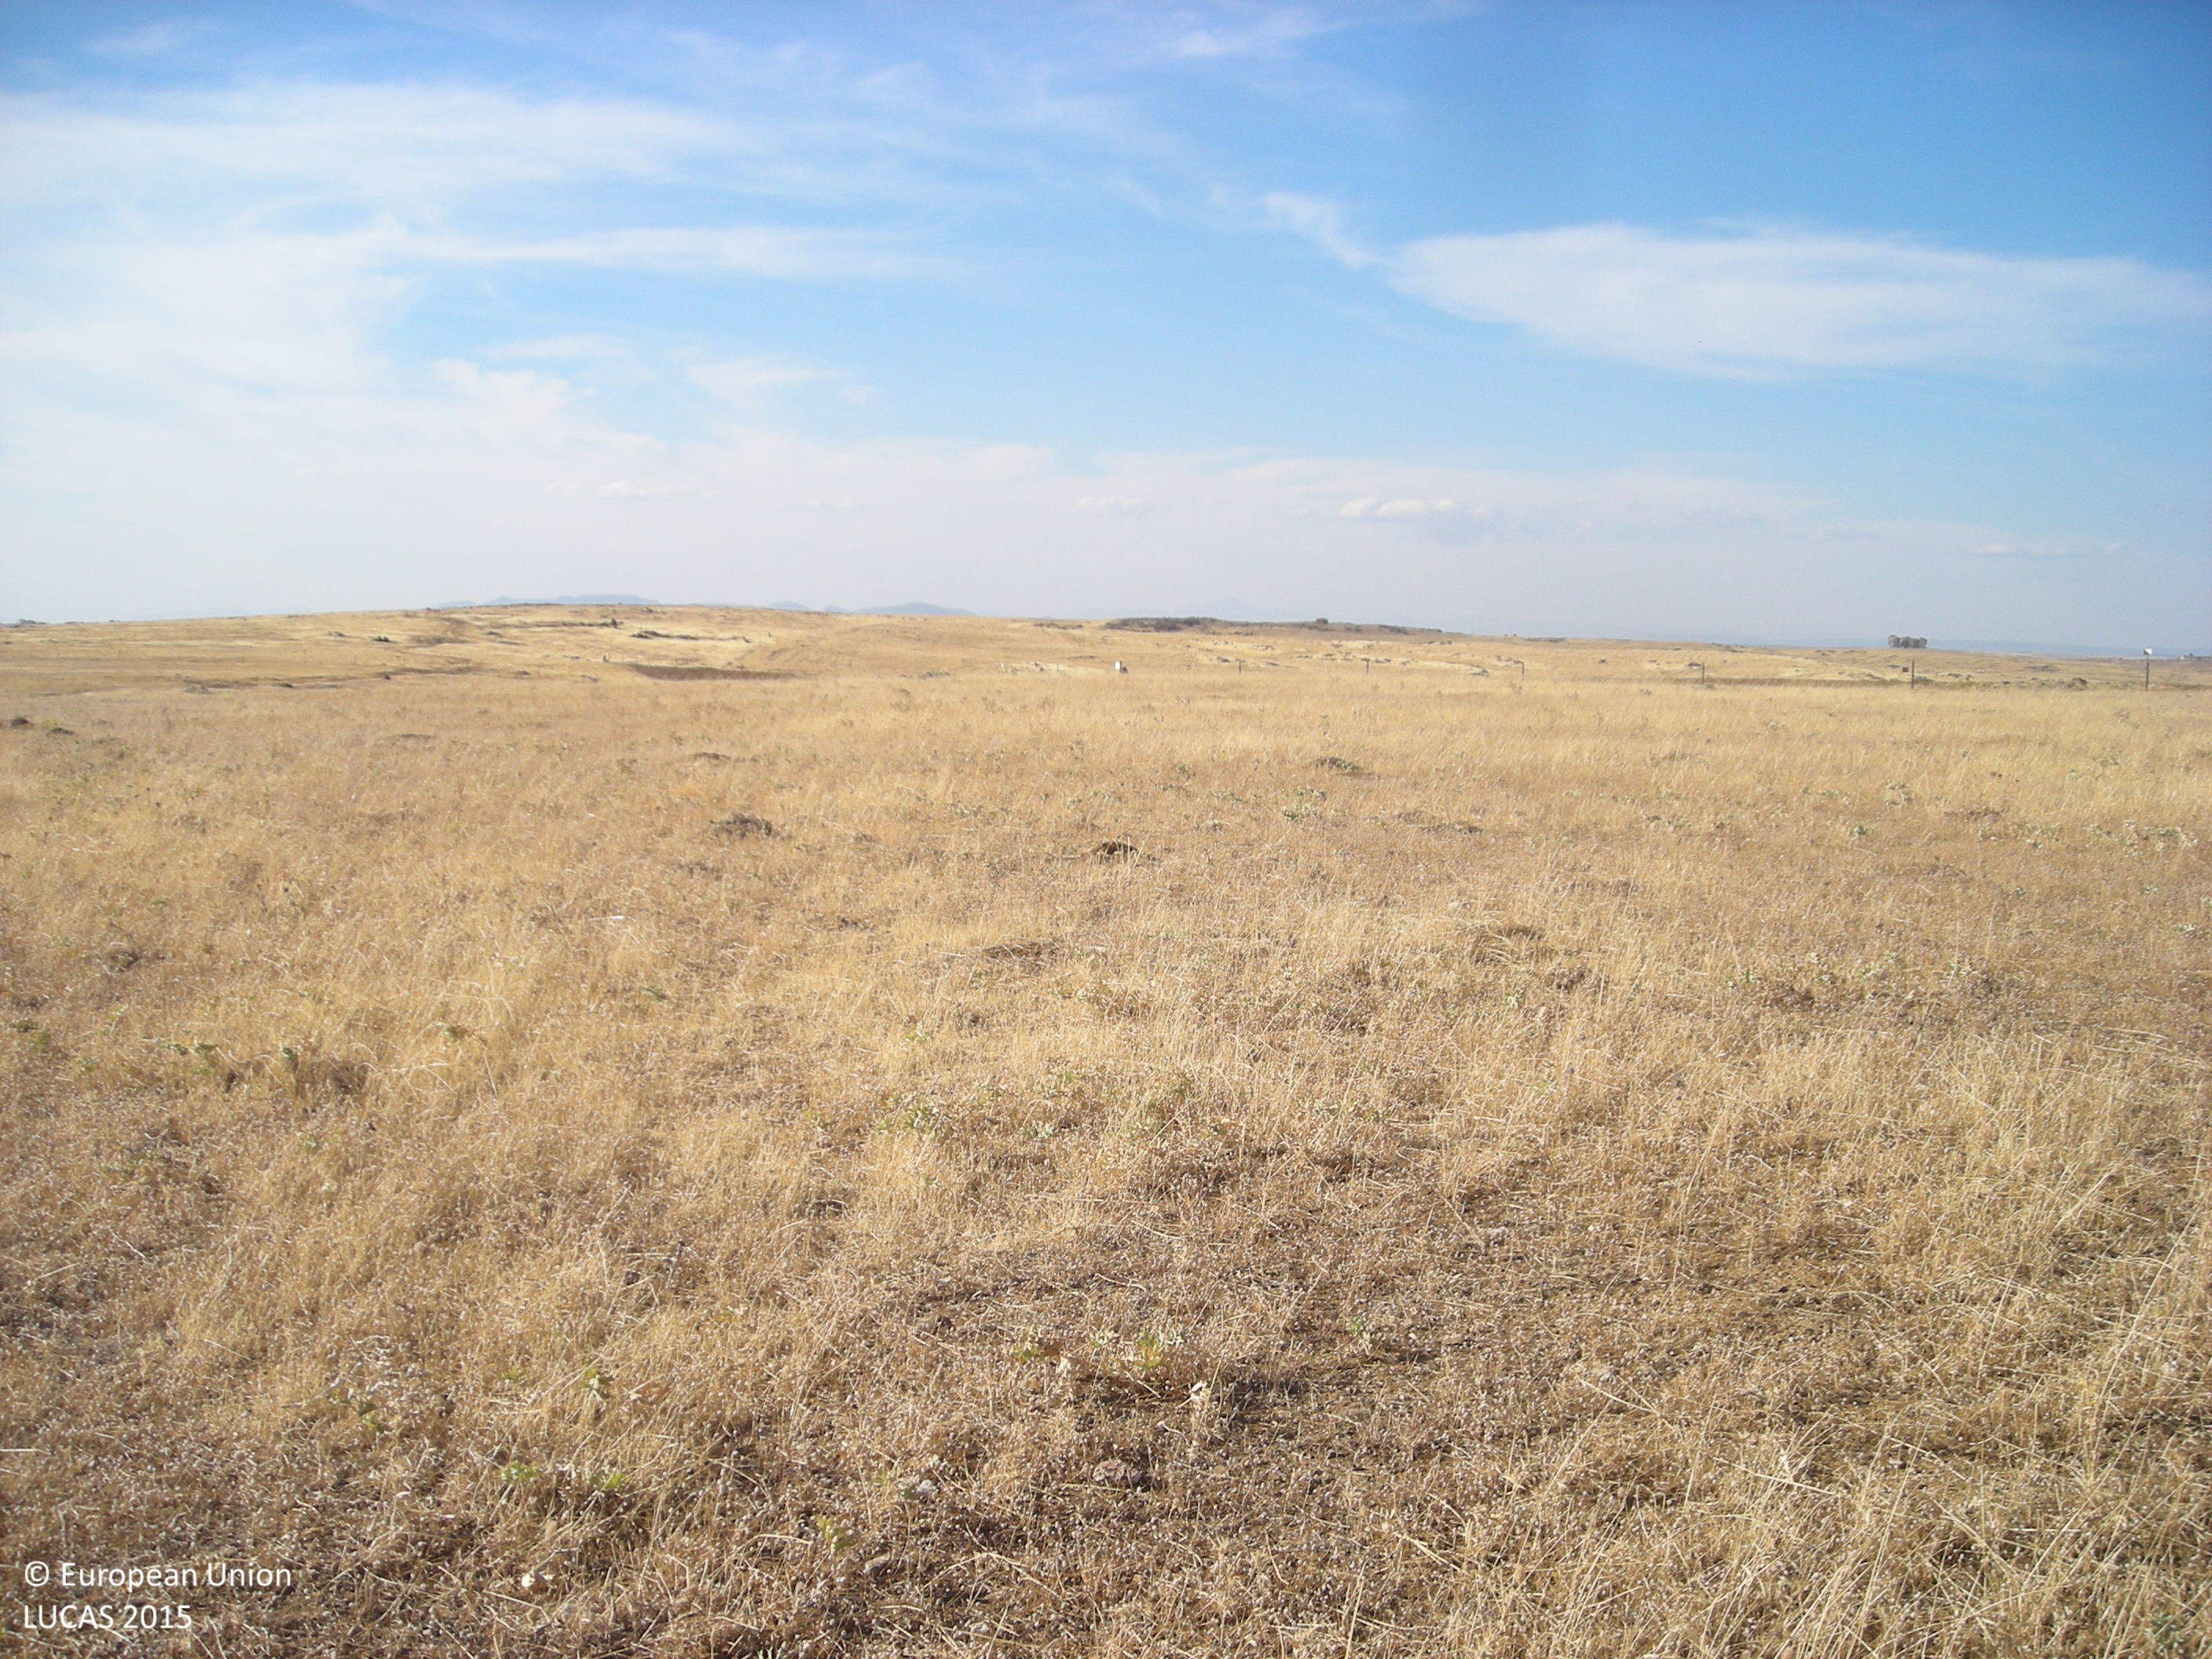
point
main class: Grassland
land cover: Grassland without tree/shrub cover
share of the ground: > 75 %
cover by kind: herbaceous plants 100 %
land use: Agriculture (excluding fallow land and kitchen gardens)
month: July
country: ES
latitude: 38.7988
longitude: -5.4337
